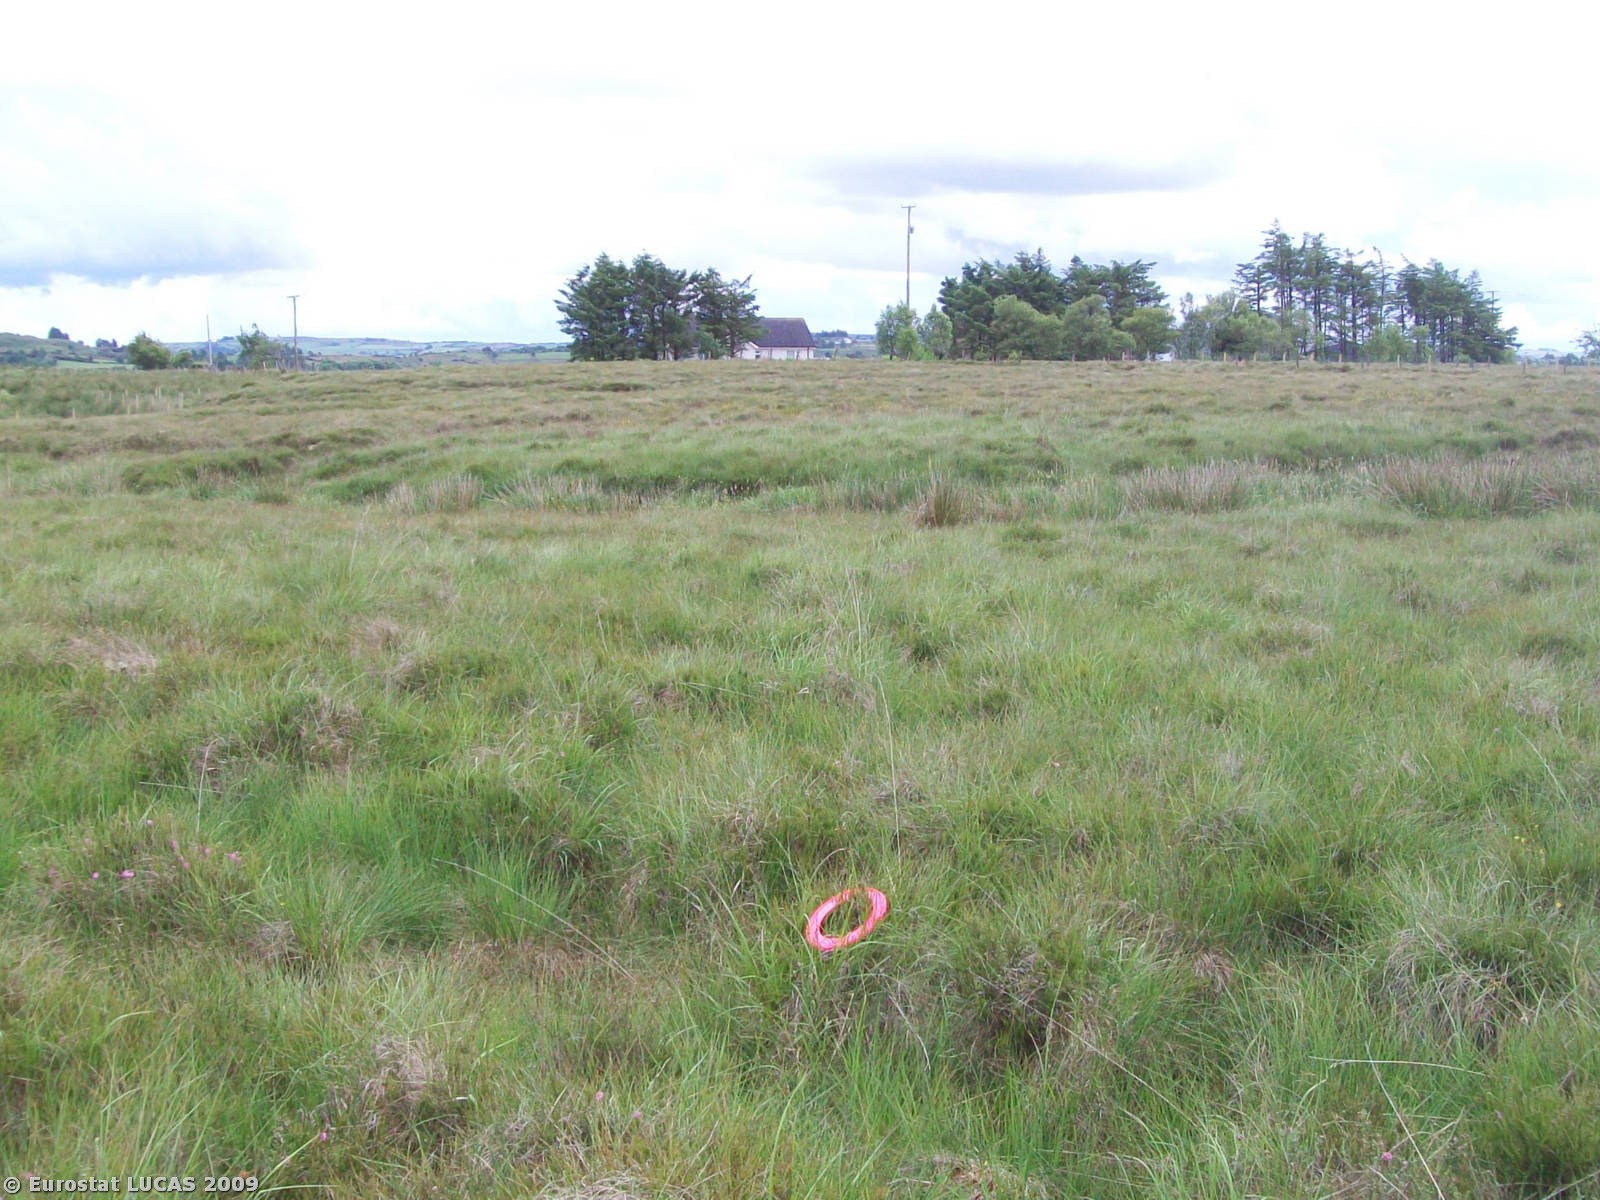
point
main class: Wetlands
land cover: Peatbogs
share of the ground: > 75 %
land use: Unused
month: July
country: GB
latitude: 54.7159
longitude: -6.9491
